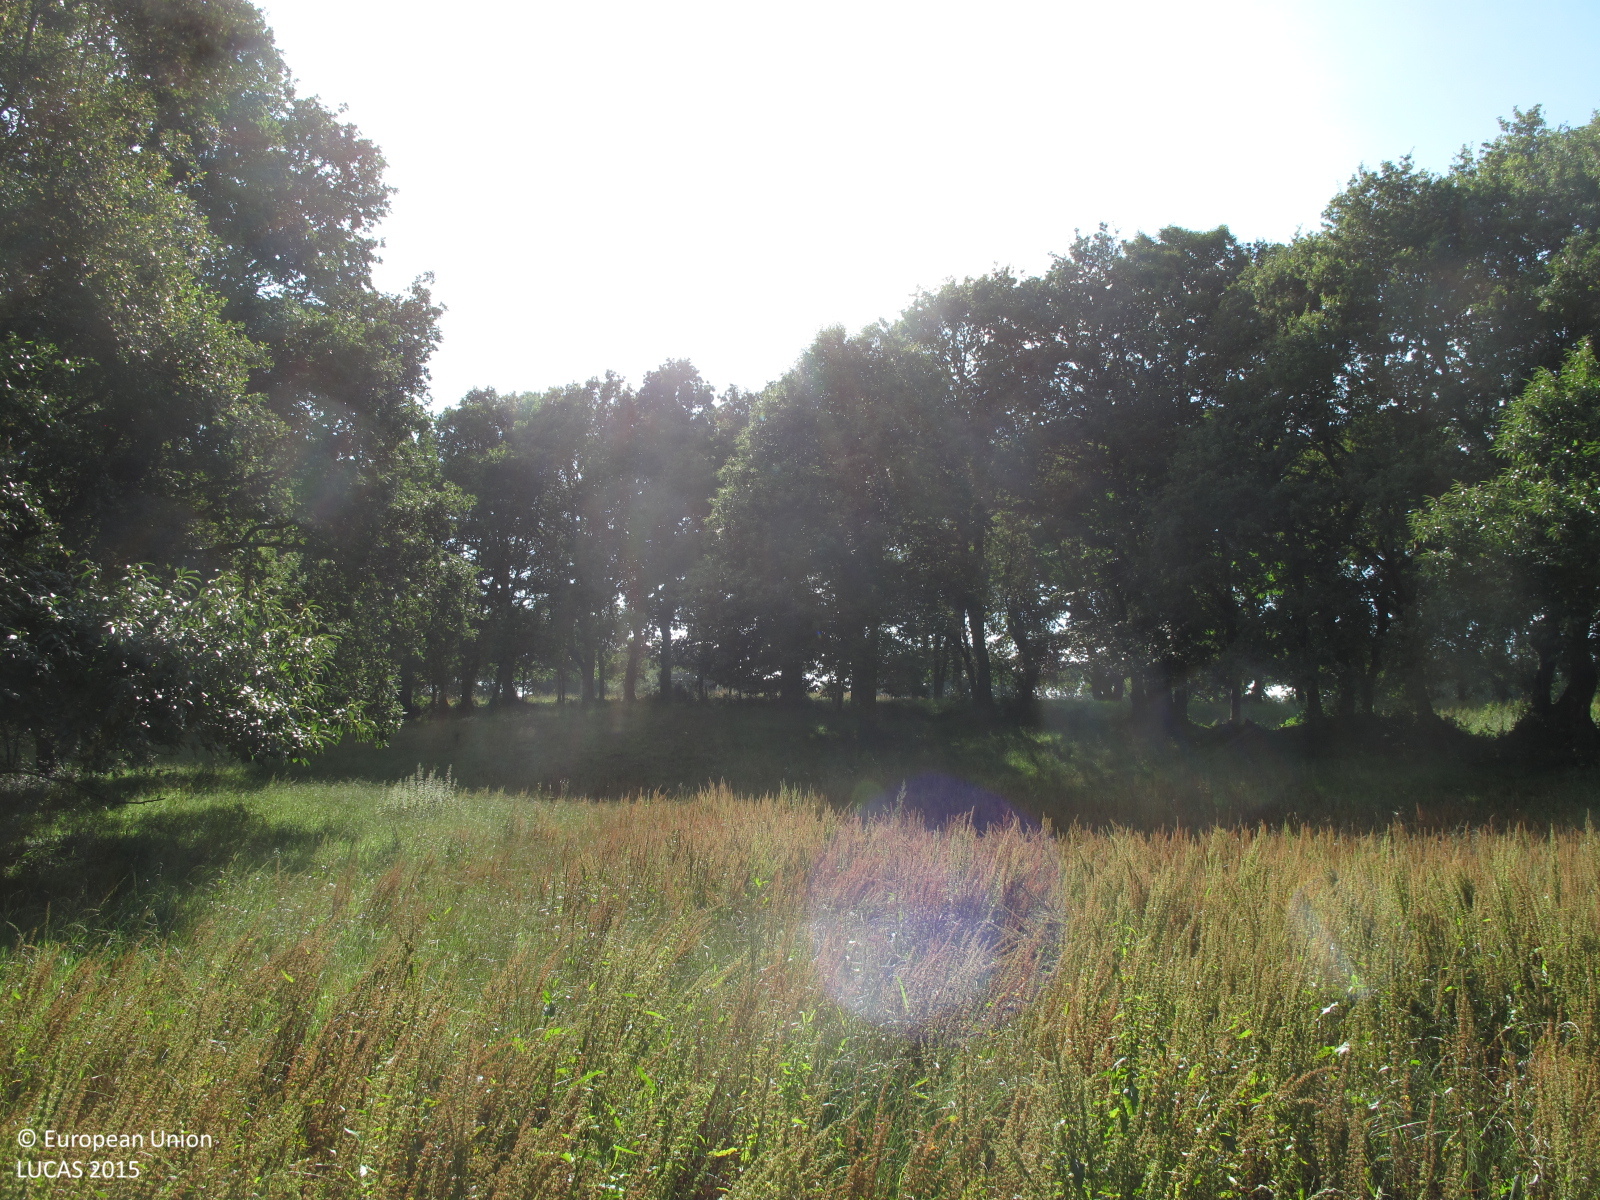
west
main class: Grassland
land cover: Grassland without tree/shrub cover
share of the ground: > 75 %
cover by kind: herbaceous plants 100 %
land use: Agriculture (excluding fallow land and kitchen gardens)
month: July
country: ES
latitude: 43.0942
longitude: -7.9907
